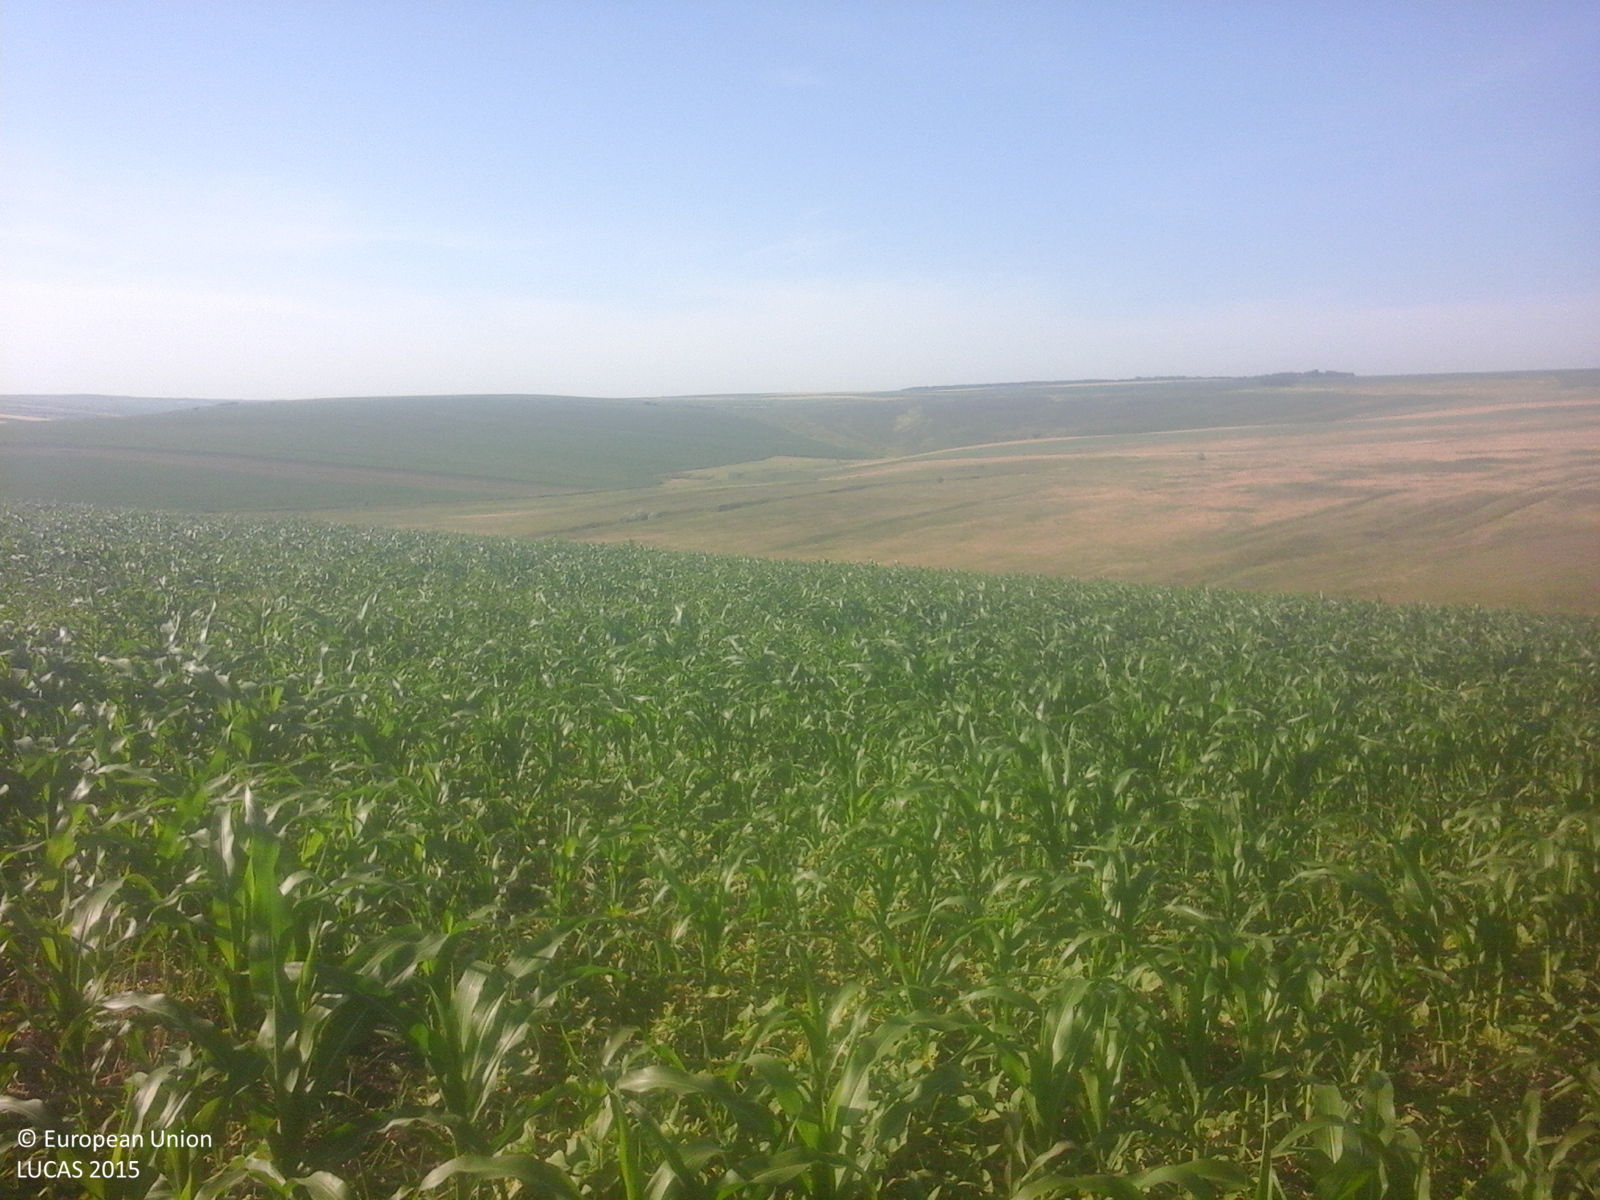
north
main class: Cropland
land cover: Maize
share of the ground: 50 - 75 %
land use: Agriculture (excluding fallow land and kitchen gardens)
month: June
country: RO
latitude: 47.9187
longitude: 27.0071
